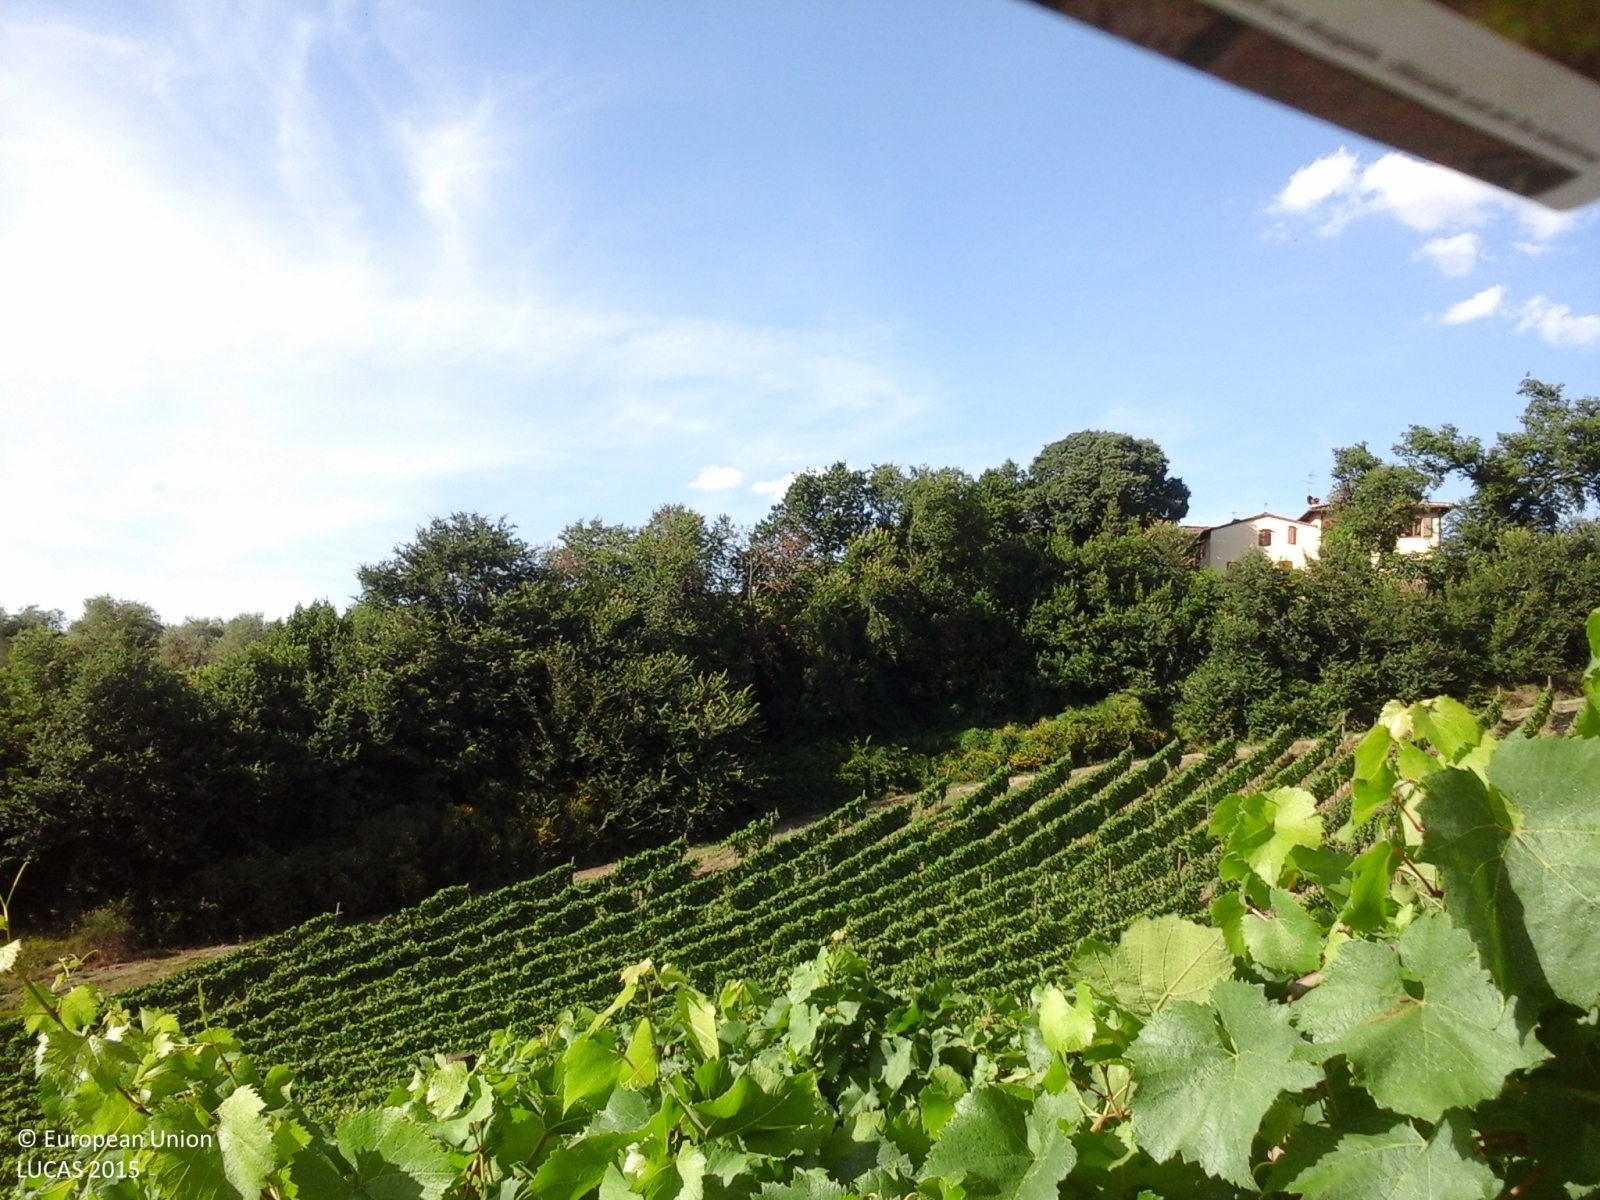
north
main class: Cropland
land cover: Vineyards
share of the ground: 50 - 75 %
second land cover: Grassland without tree/shrub cover
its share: 50 - 75 %
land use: Agriculture (excluding fallow land and kitchen gardens)
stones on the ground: < 10 %
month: June
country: IT
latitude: 43.7490
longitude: 11.1271
